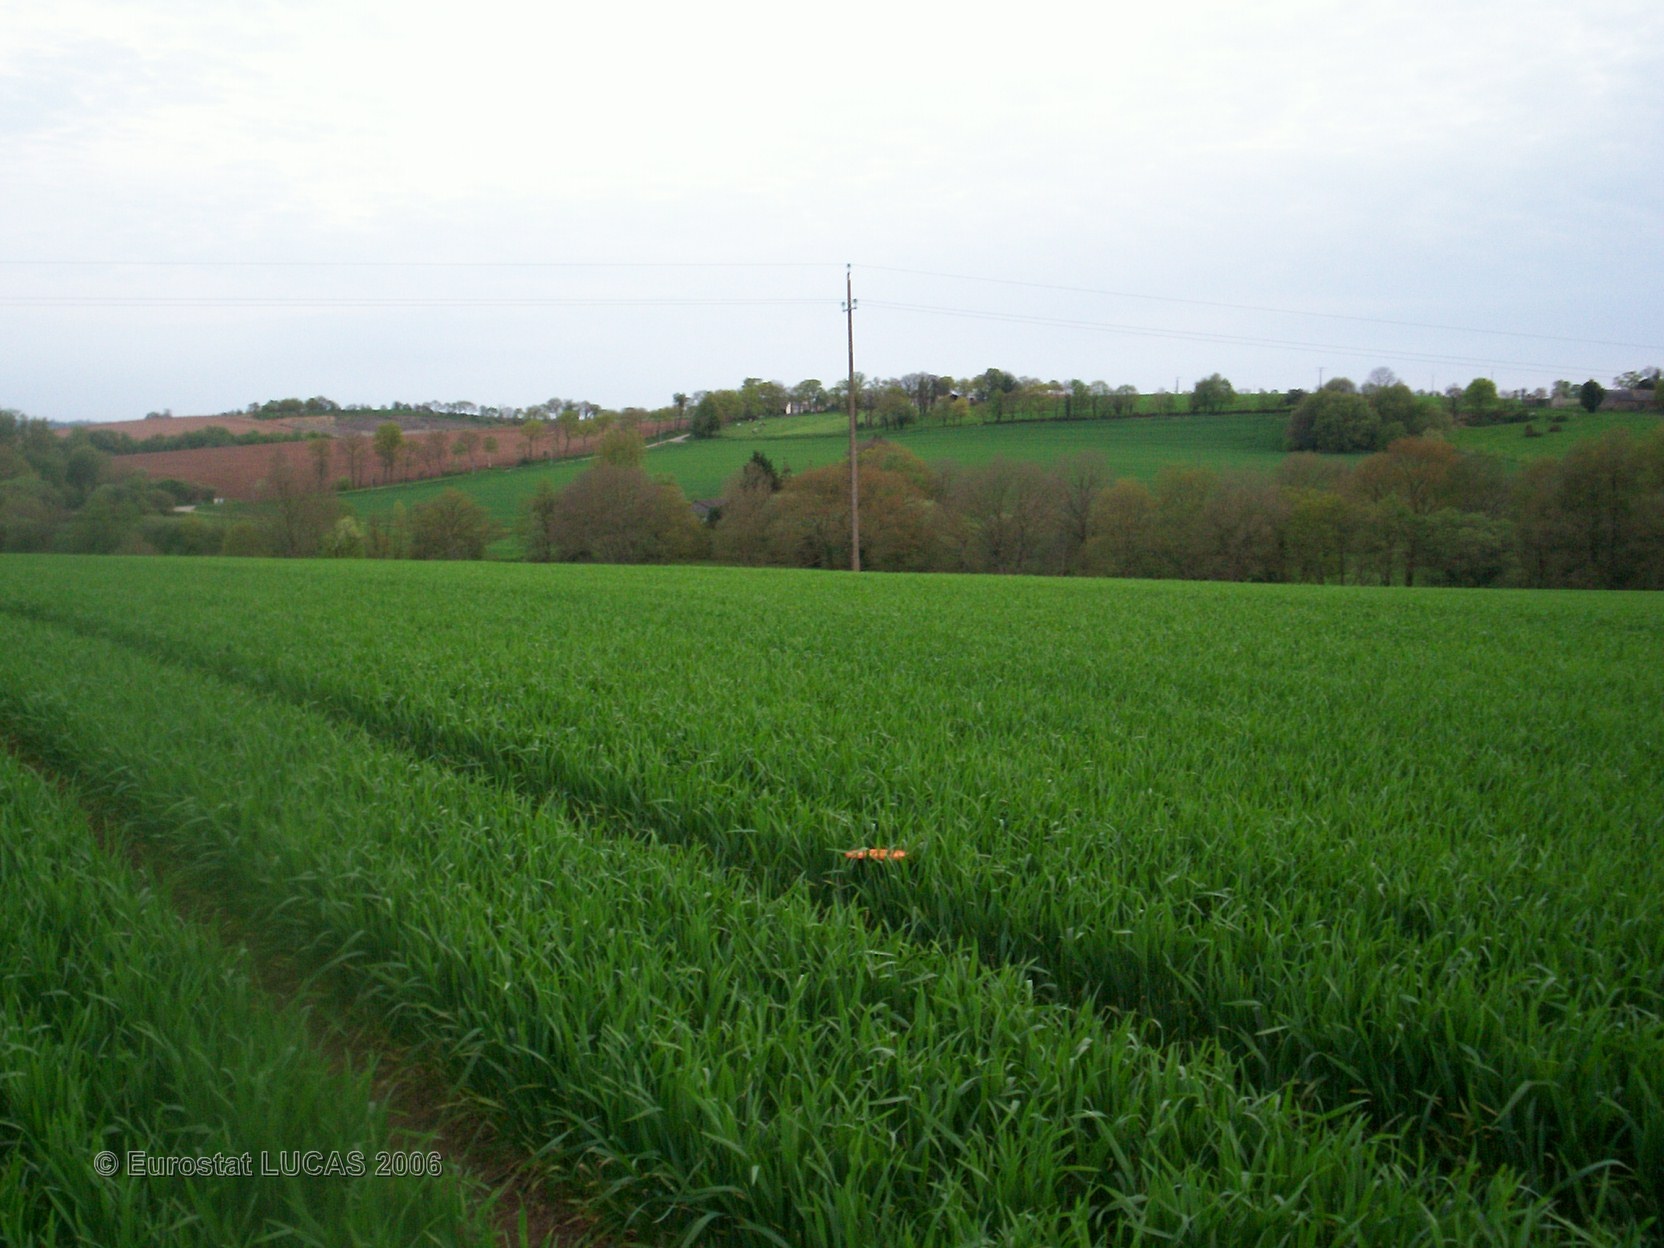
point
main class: Cropland
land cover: Common wheat
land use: Agriculture (excluding fallow land and kitchen gardens)
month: May
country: FR
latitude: 47.9768
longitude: -2.8590
